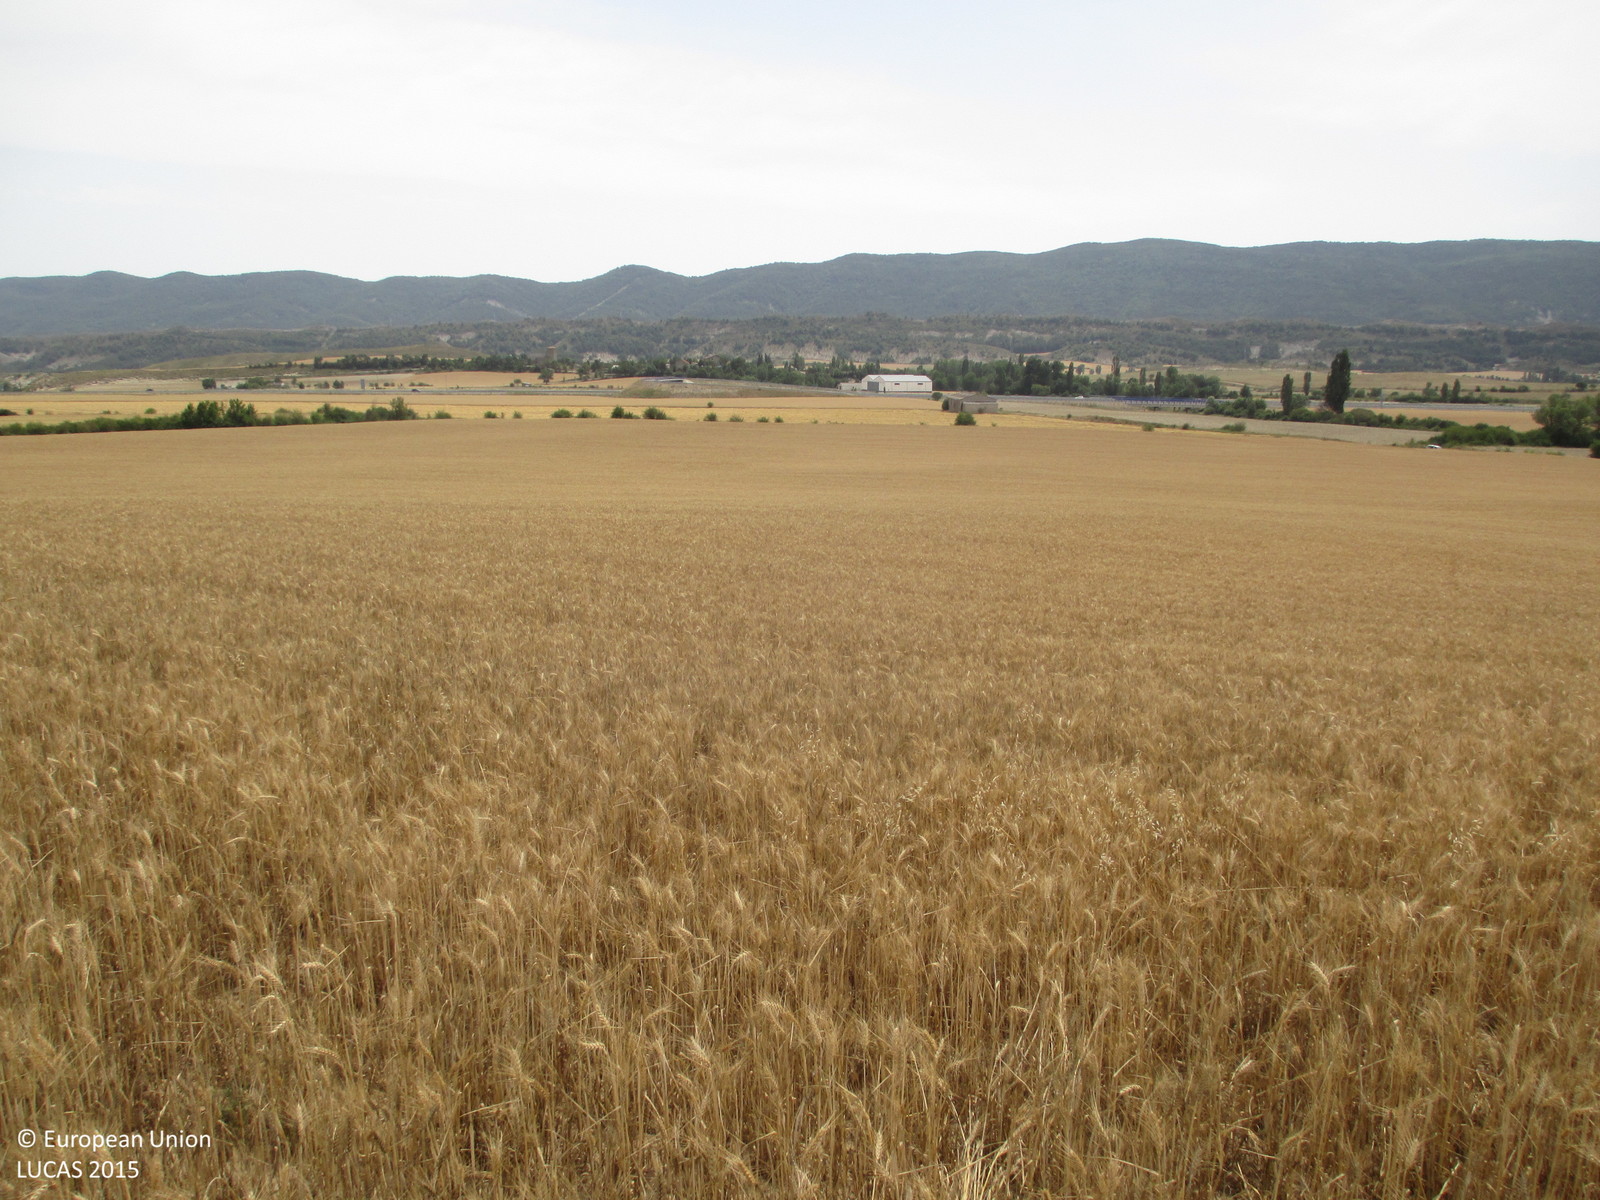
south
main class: Cropland
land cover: Common wheat
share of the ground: > 75 %
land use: Agriculture (excluding fallow land and kitchen gardens)
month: July
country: ES
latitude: 42.5524
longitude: -0.4144
